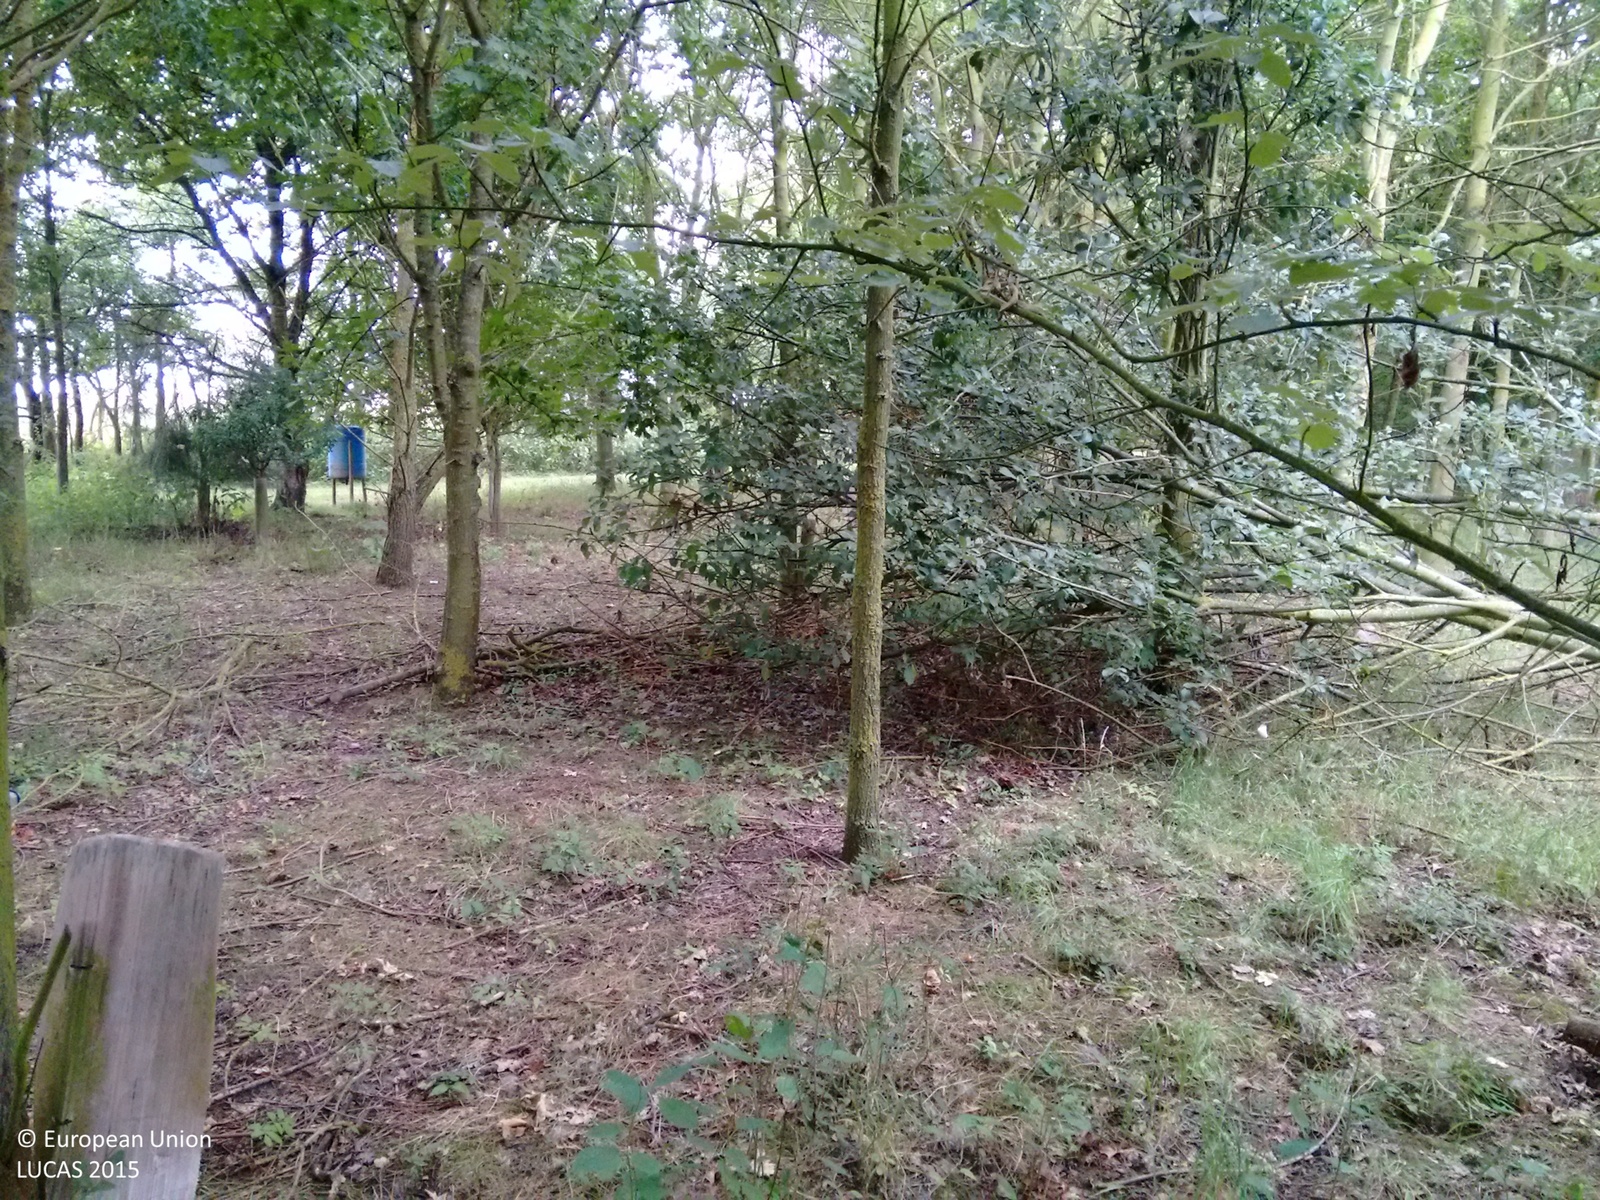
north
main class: Woodland
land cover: Other mixed woodland
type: exotic forest
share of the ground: > 75 %
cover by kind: broadleaved forest trees 60 %, coniferous forest trees 40 %
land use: Sport
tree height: > 5 m
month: August
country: GB
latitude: 52.3794
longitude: 0.3190
